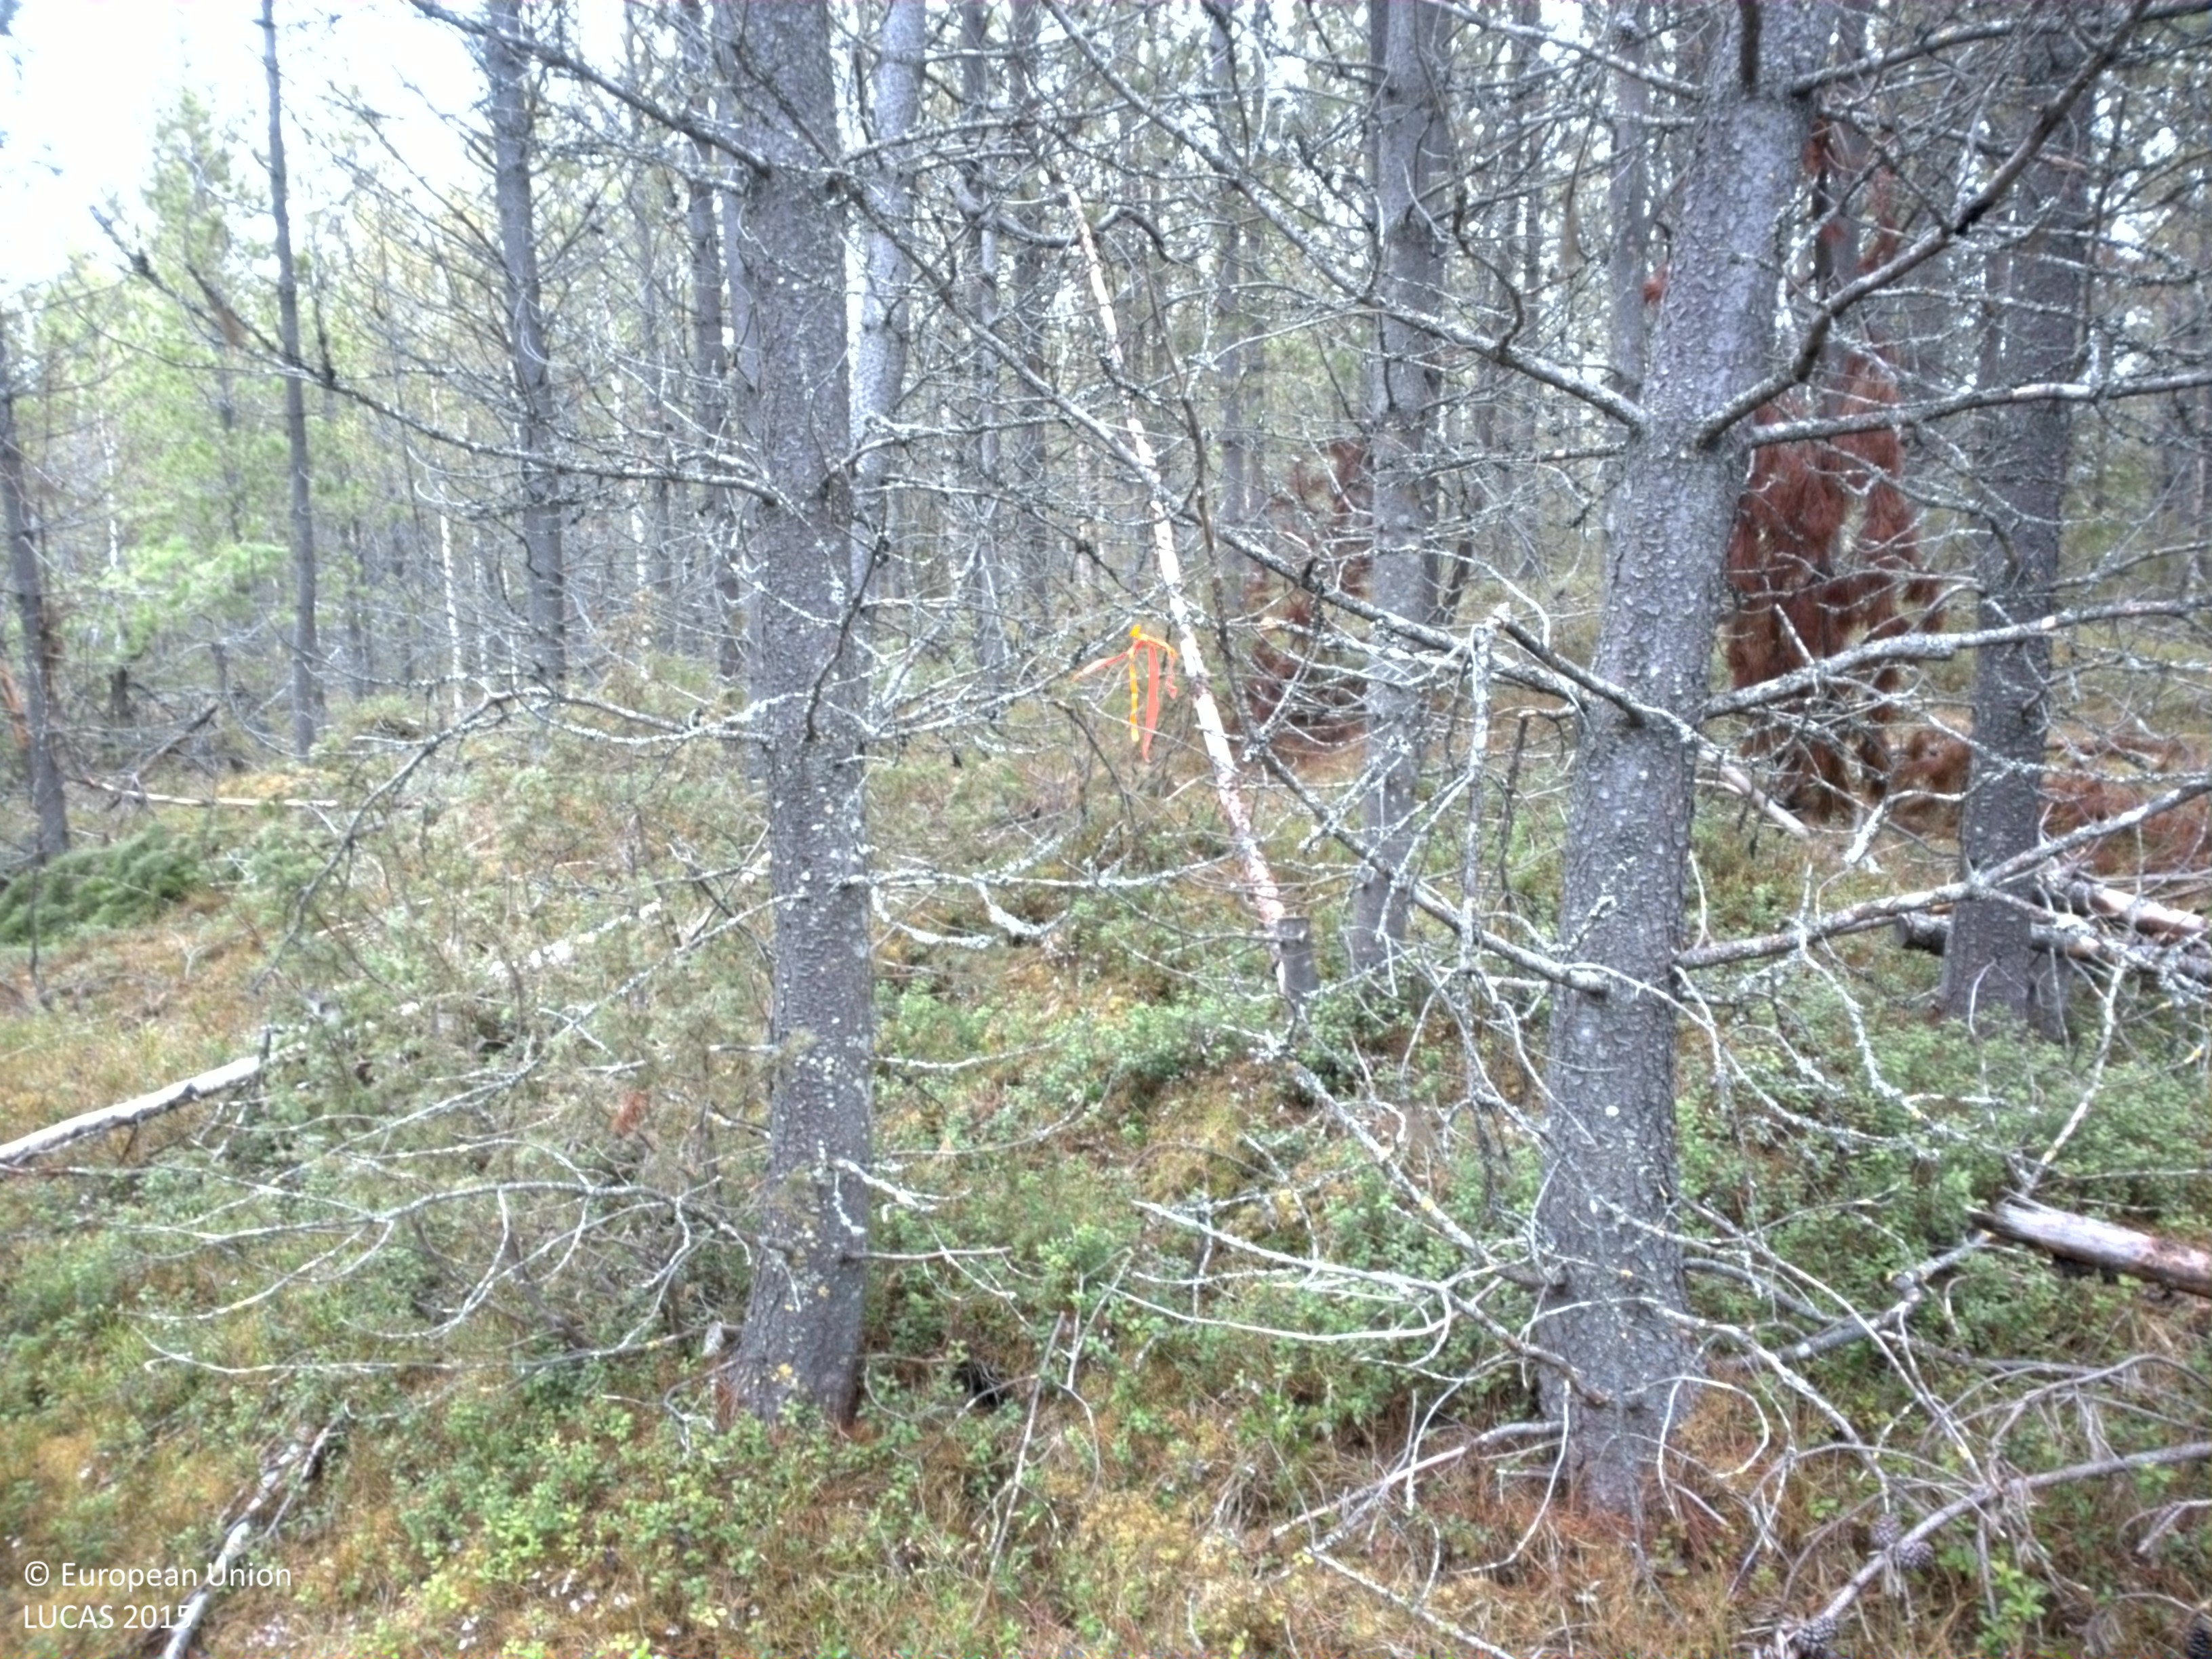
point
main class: Woodland
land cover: Pine dominated coniferous woodland
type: exotic forest
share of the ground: 25 - 50 %
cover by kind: coniferous forest trees 45 %, herbaceous plants 25 %, lichens and mosses 15 %, shrubs 10 %, broadleaved forest trees 5 %
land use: Forestry
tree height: > 5 m
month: June
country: SE
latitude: 64.3564
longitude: 18.0663
